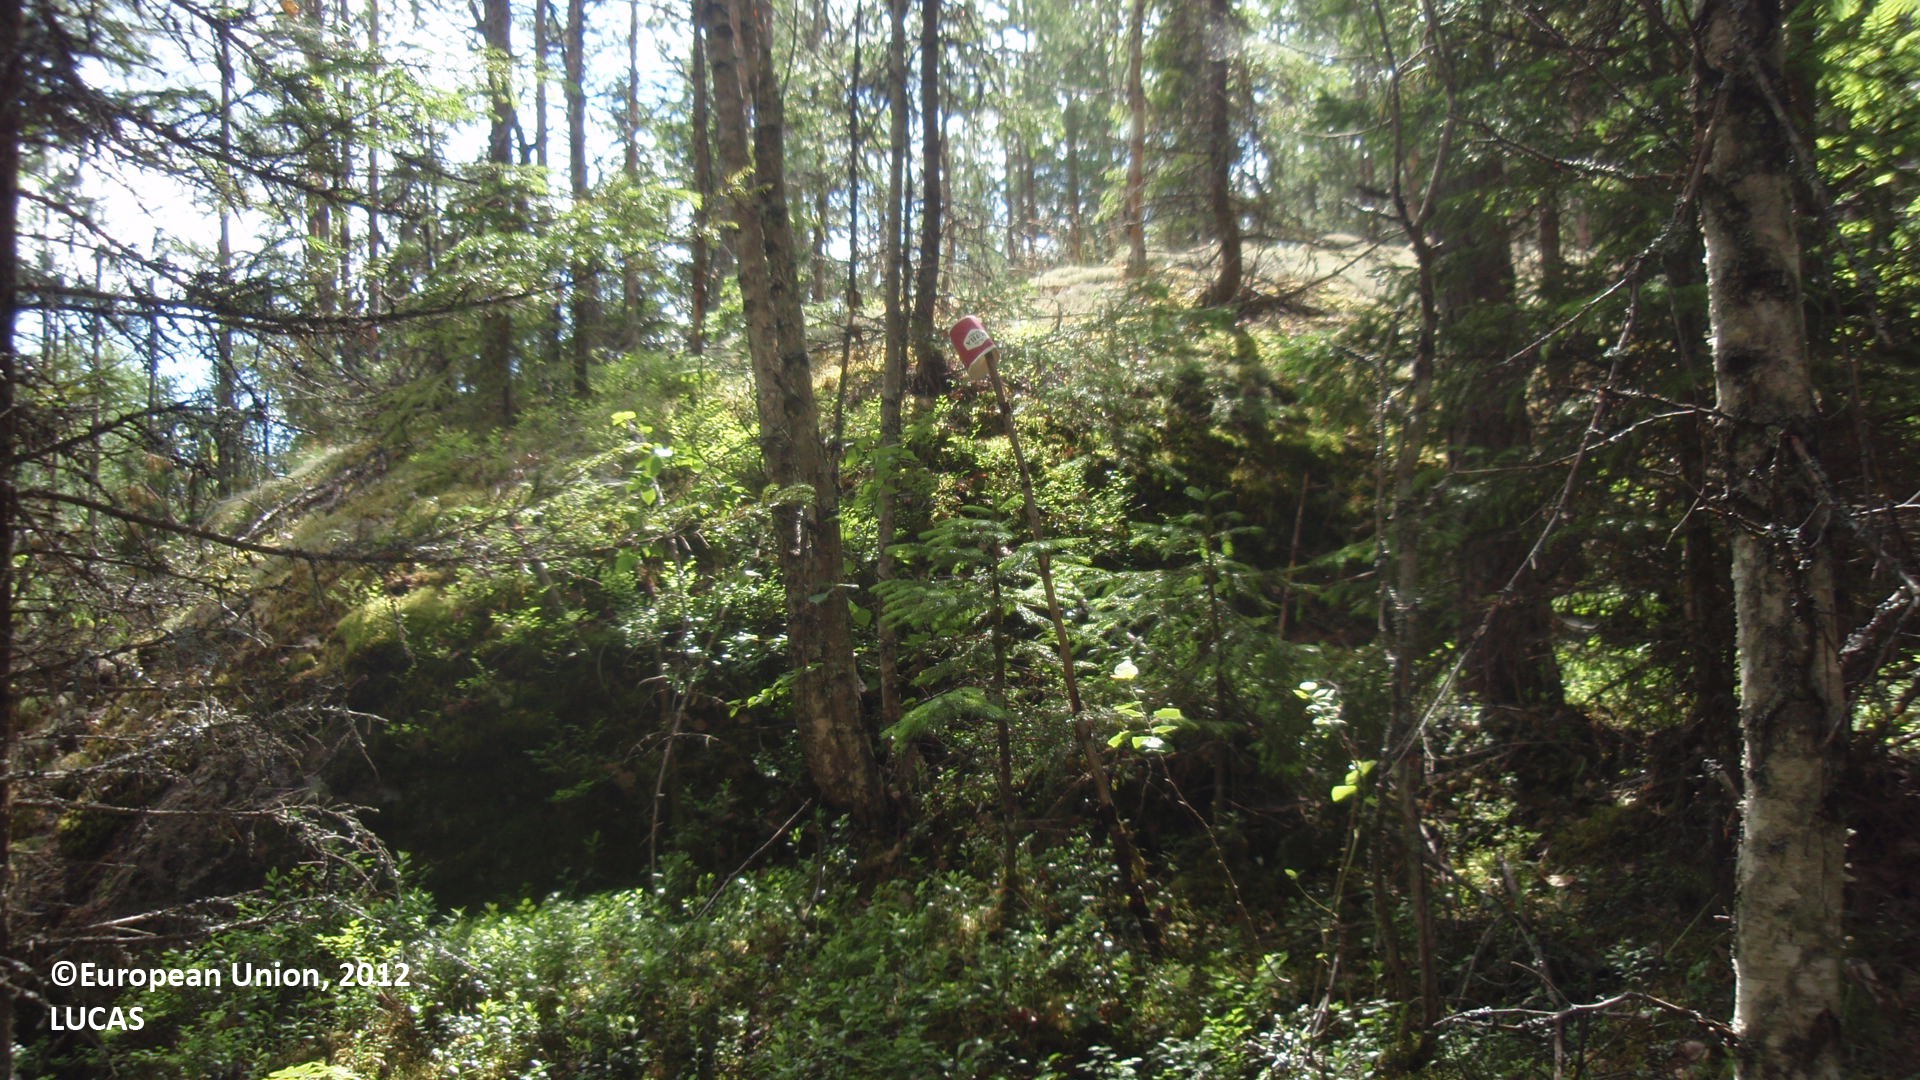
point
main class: Woodland
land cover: Spruce dominated mixed woodland
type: boreal forest
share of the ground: 25 - 50 %
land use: Semi-natural and natural areas not in use
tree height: > 5 m
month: July
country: FI
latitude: 61.6208
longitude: 28.1725
